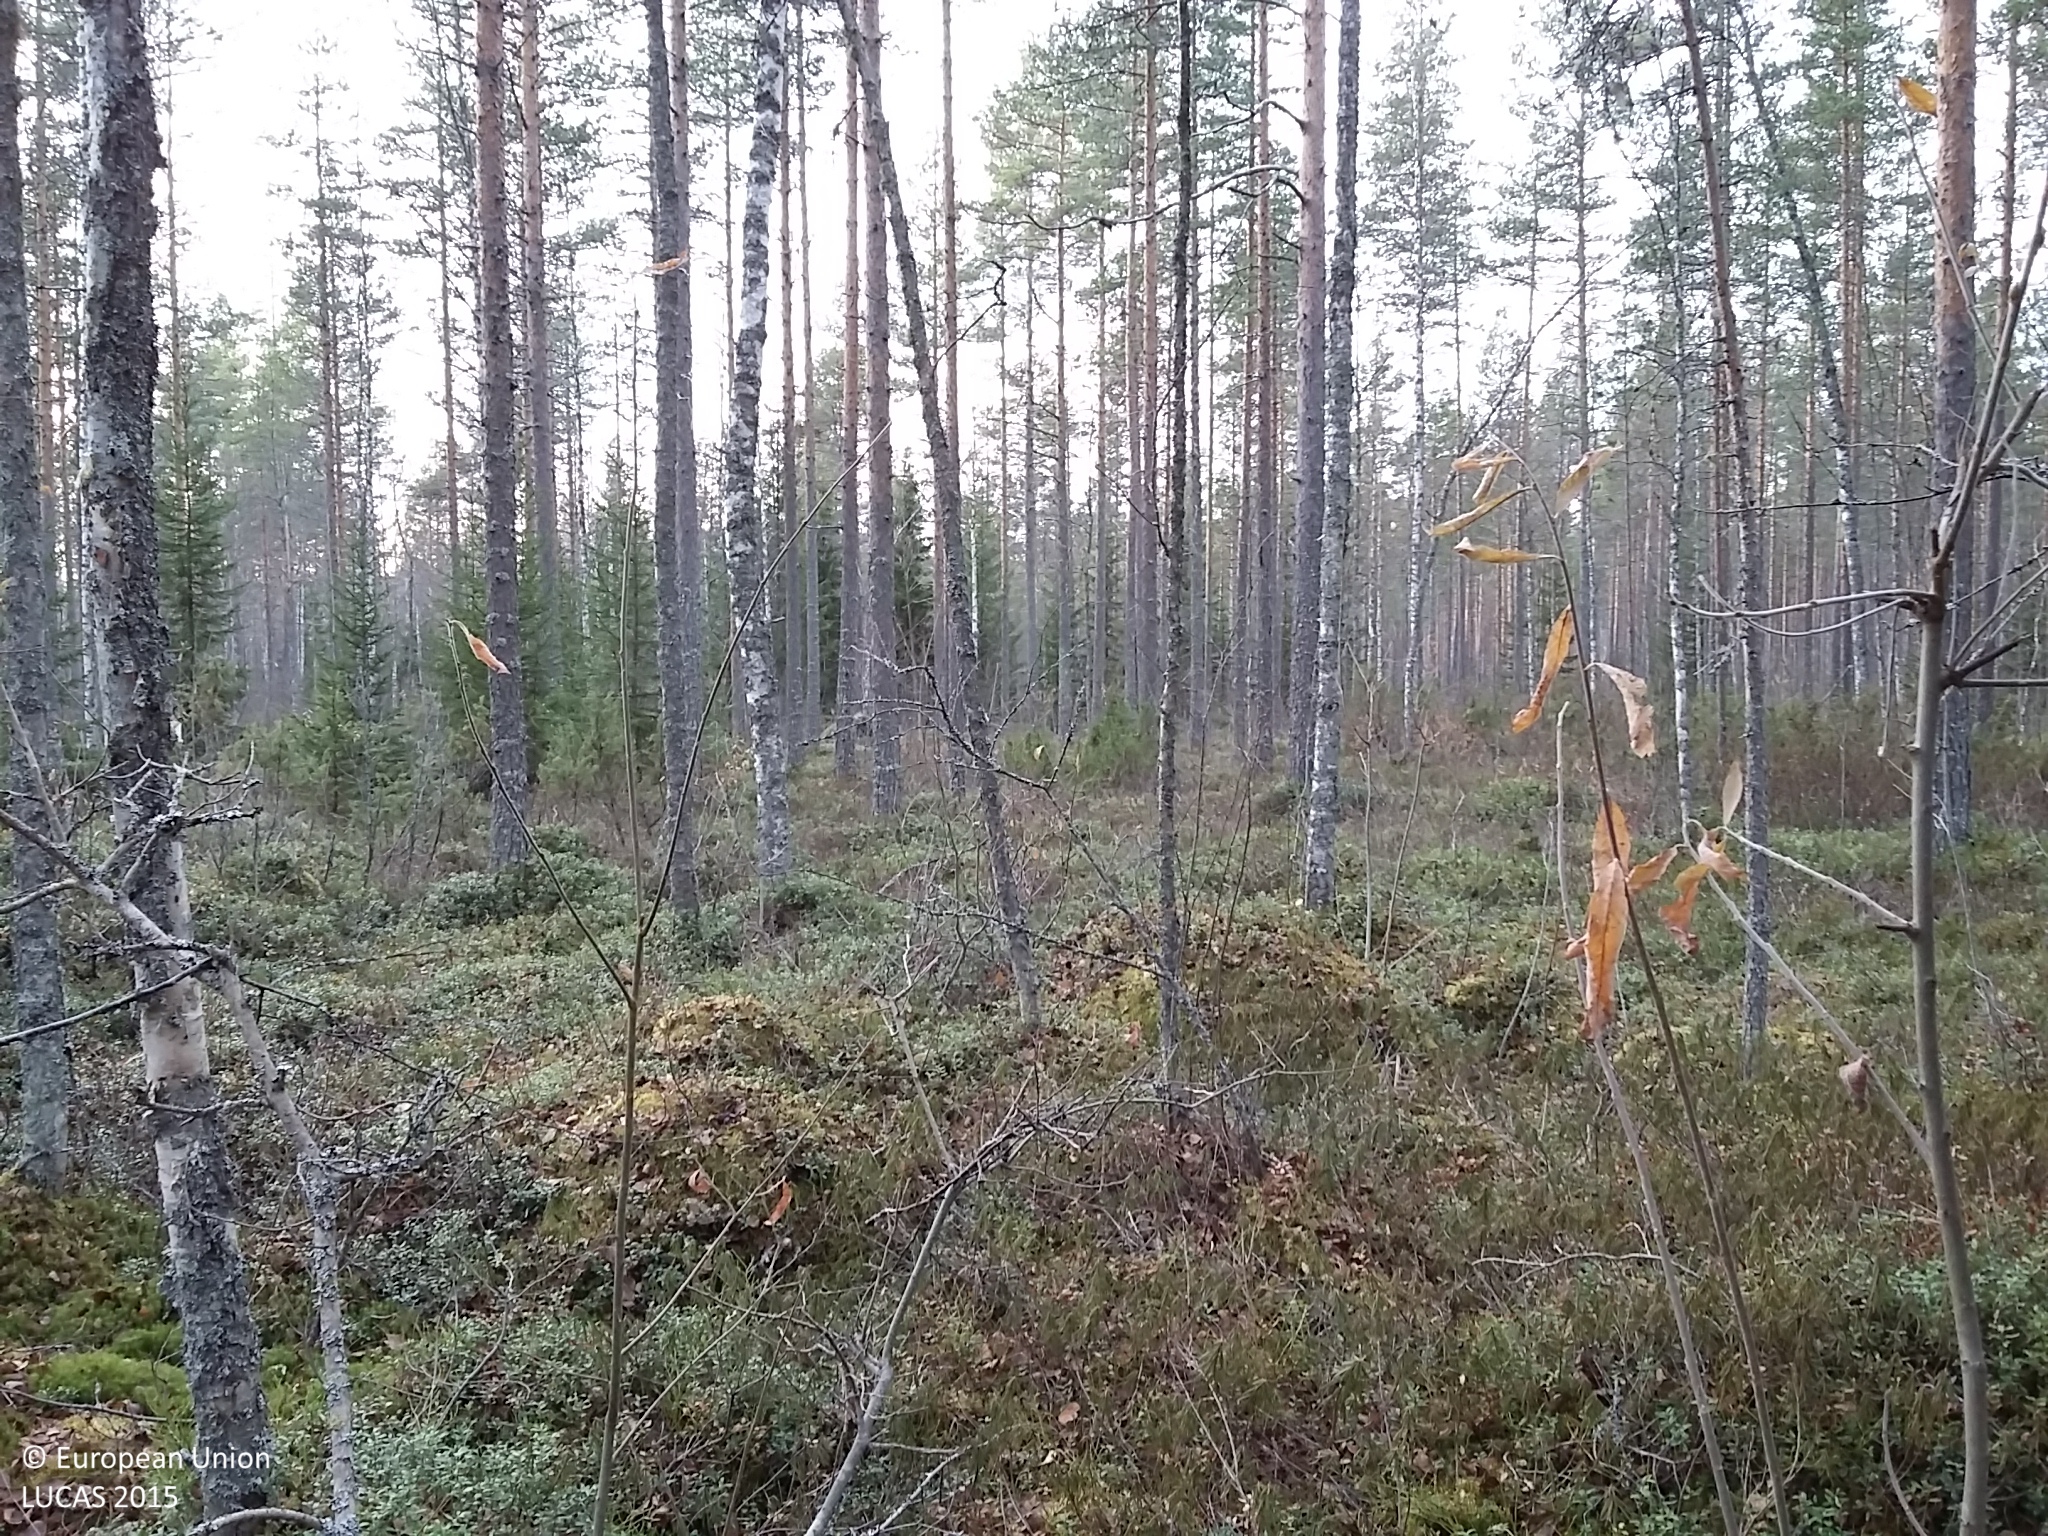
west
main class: Woodland
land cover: Pine dominated mixed woodland
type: boreal forest
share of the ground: > 75 %
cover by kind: coniferous forest trees 60 %, broadleaved forest trees 25 %, shrubs 5 %, herbaceous plants 5 %, lichens and mosses 5 %
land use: Forestry
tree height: > 5 m
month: October
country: FI
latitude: 63.9983
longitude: 24.9469
